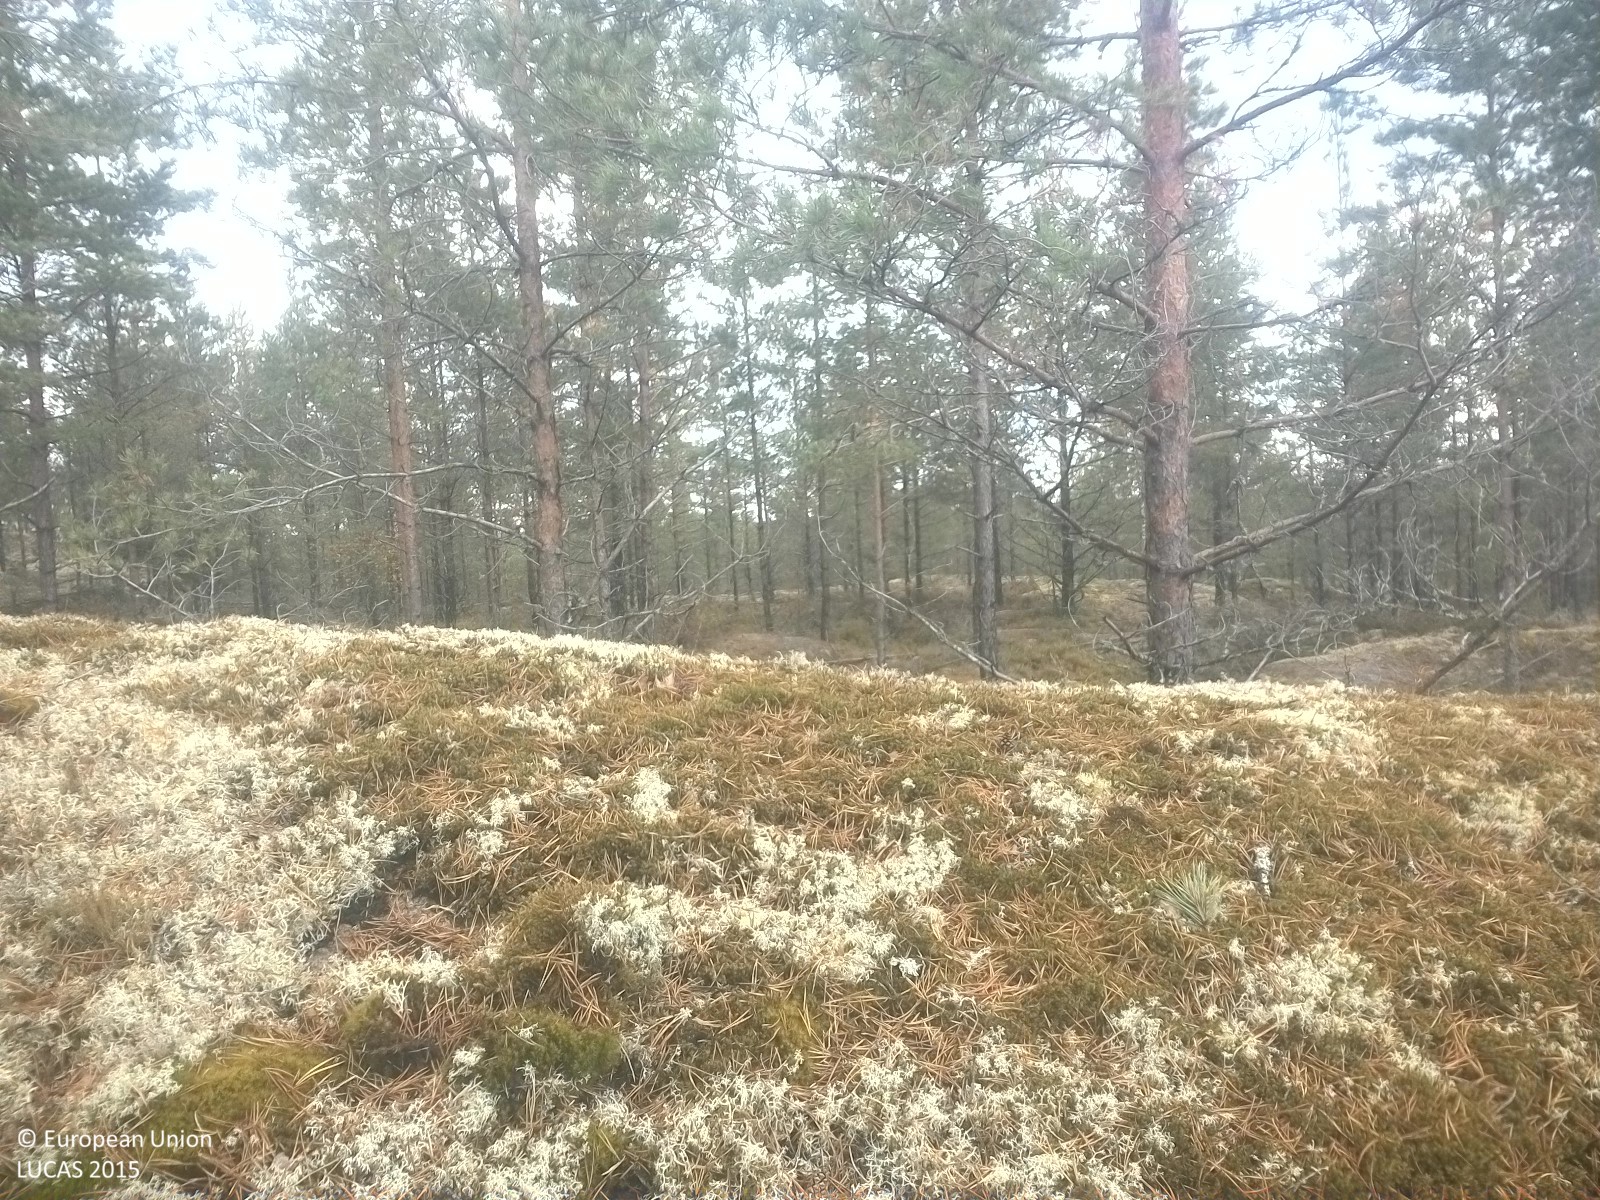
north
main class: Woodland
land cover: Pine dominated coniferous woodland
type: boreal forest
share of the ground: 10 - 25 %
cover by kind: lichens and mosses 60 %, coniferous forest trees 20 %, shrubs 15 %, herbaceous plants 5 %
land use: Forestry
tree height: < 5 m
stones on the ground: 10 - 25 %
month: September
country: SE
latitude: 58.7981
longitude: 16.2073
